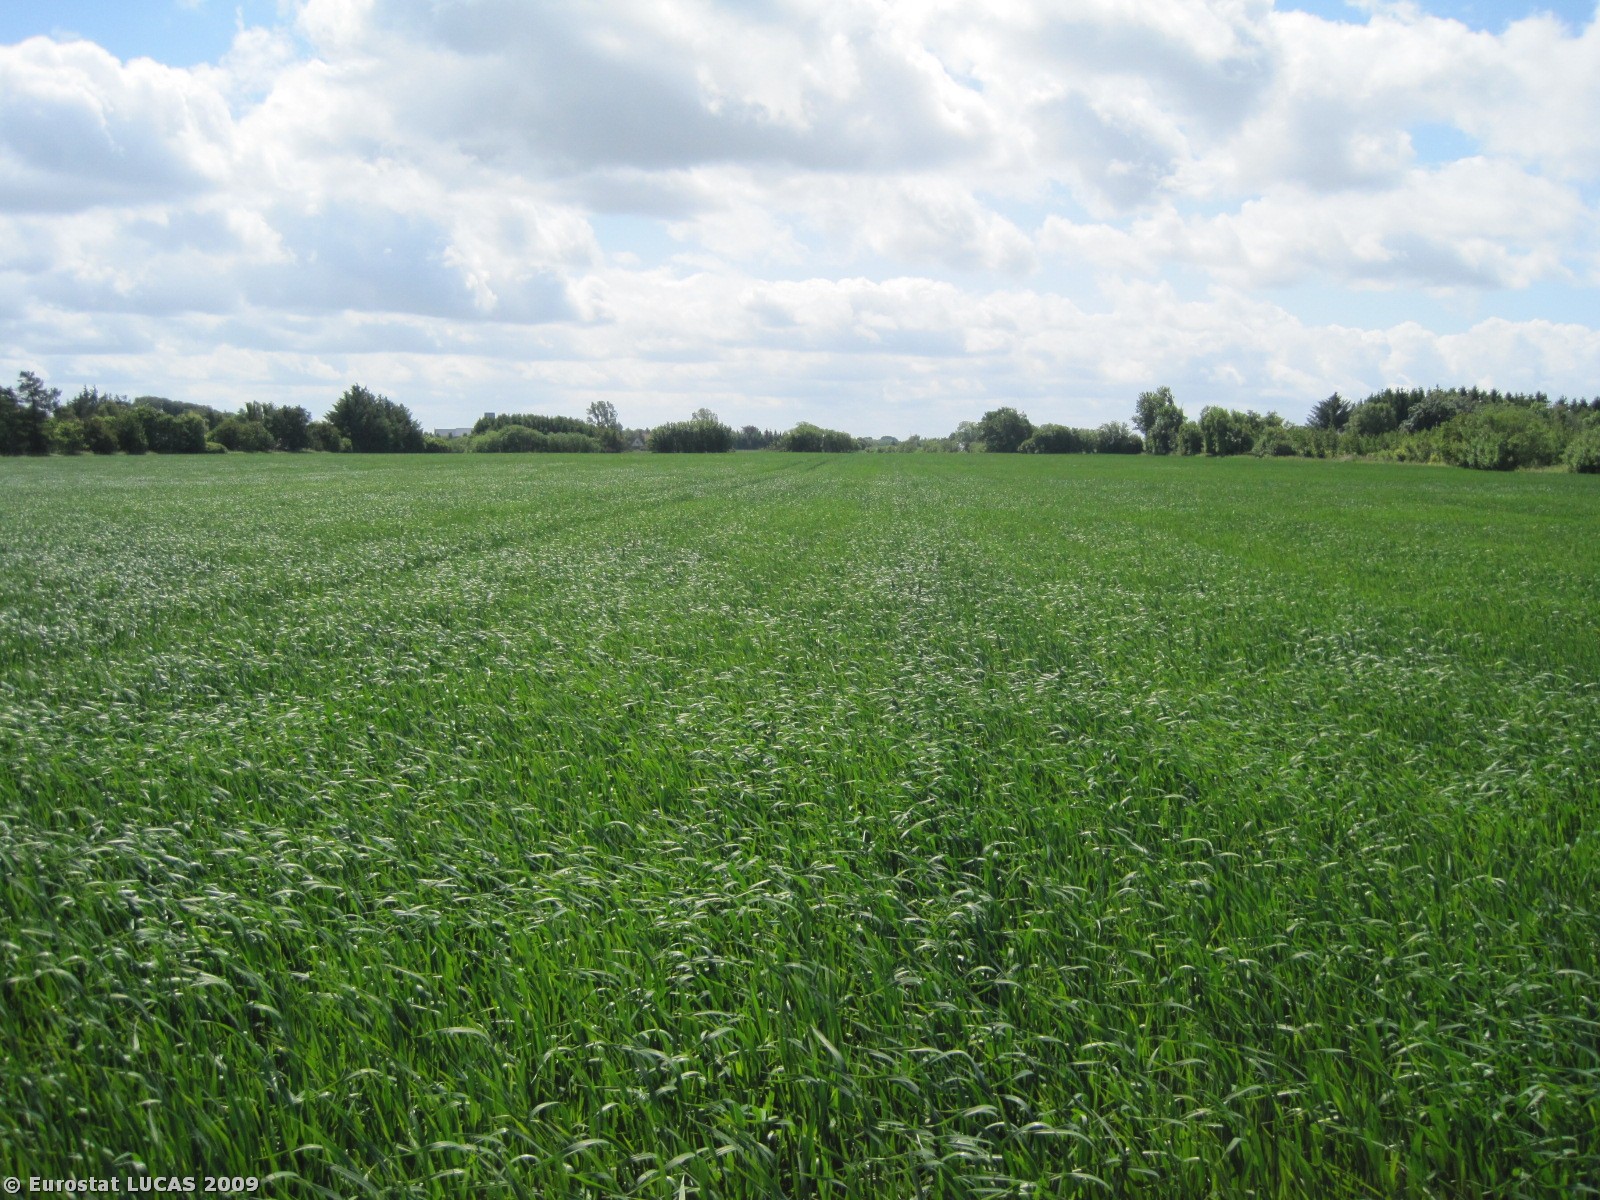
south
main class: Cropland
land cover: Oats
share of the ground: > 75 %
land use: Agriculture (excluding fallow land and kitchen gardens)
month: June
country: DK
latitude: 57.1225
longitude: 9.8846
